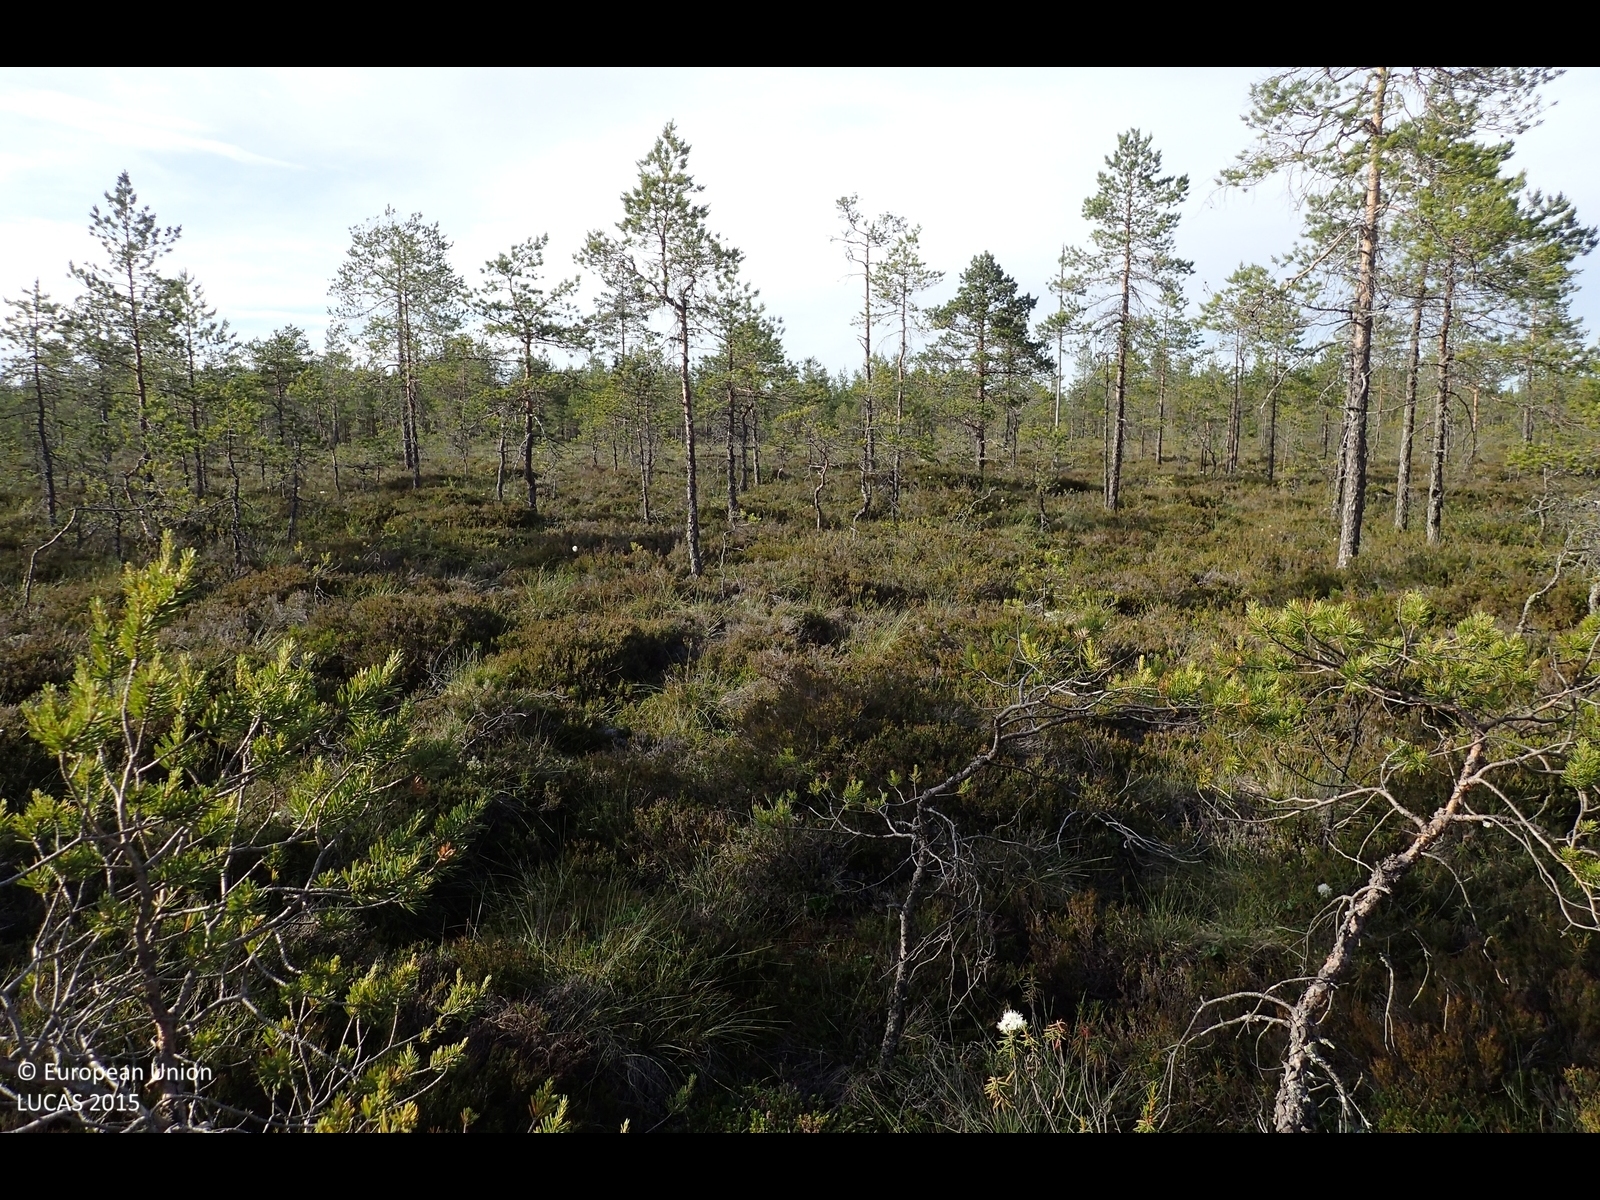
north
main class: Woodland
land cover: Pine dominated coniferous woodland
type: mire and swamp forests
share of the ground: 25 - 50 %
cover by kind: shrubs 65 %, coniferous forest trees 30 %, lichens and mosses 5 %
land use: Forestry
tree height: < 5 m
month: July
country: FI
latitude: 62.5450
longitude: 21.6121
